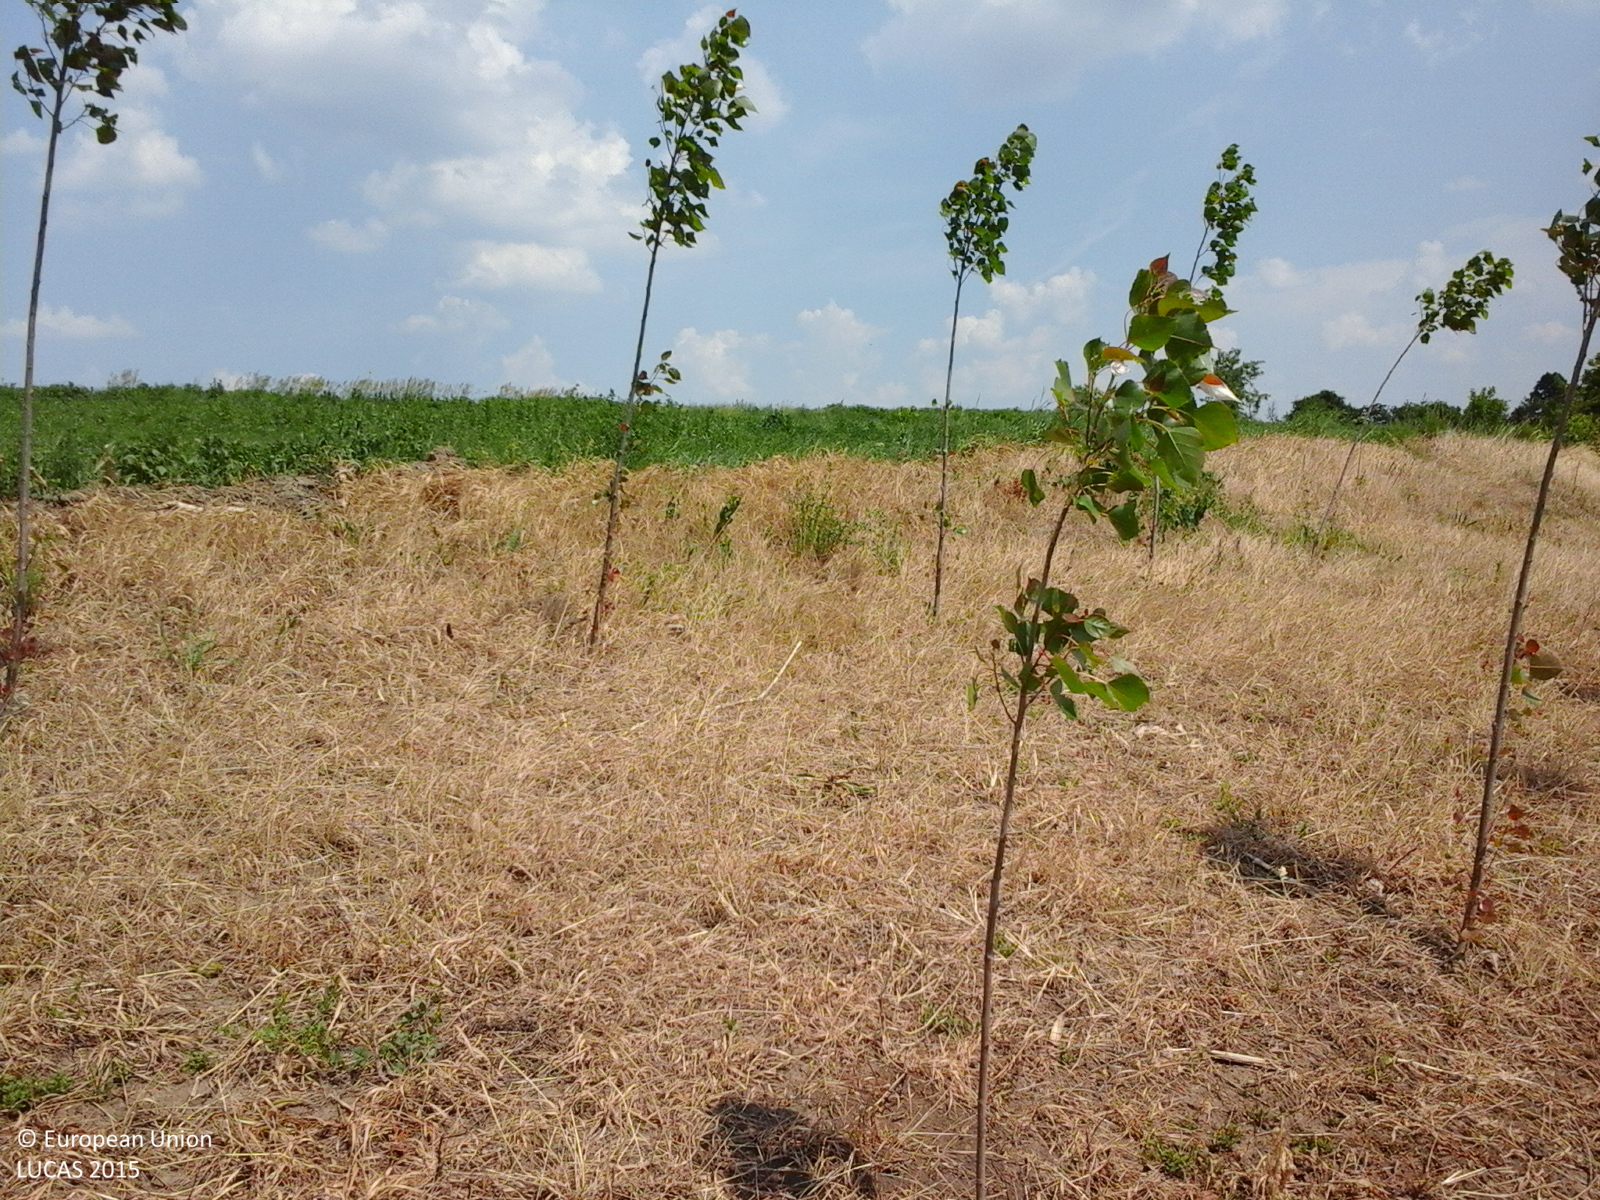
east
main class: Woodland
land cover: Broadleaved woodland
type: non-riverine alder, birch or aspen forest
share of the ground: 10 - 25 %
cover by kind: herbaceous plants 60 %, broadleaved forest trees 40 %
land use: Forestry
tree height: < 5 m
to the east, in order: Broadleaved woodland; Grassland without tree/shrub cover; Electric lines; Lucerne; Grass margins; Ditches and canals; Grass margins; Paved roads, cycling and walking lanes; Grass margins; Ditches and canals; Grass margins; Maize; Lucerne; Sunflower; Tracks; Maize; Lucerne; Maize; Lucerne
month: June
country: RO
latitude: 46.9162
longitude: 26.8359
